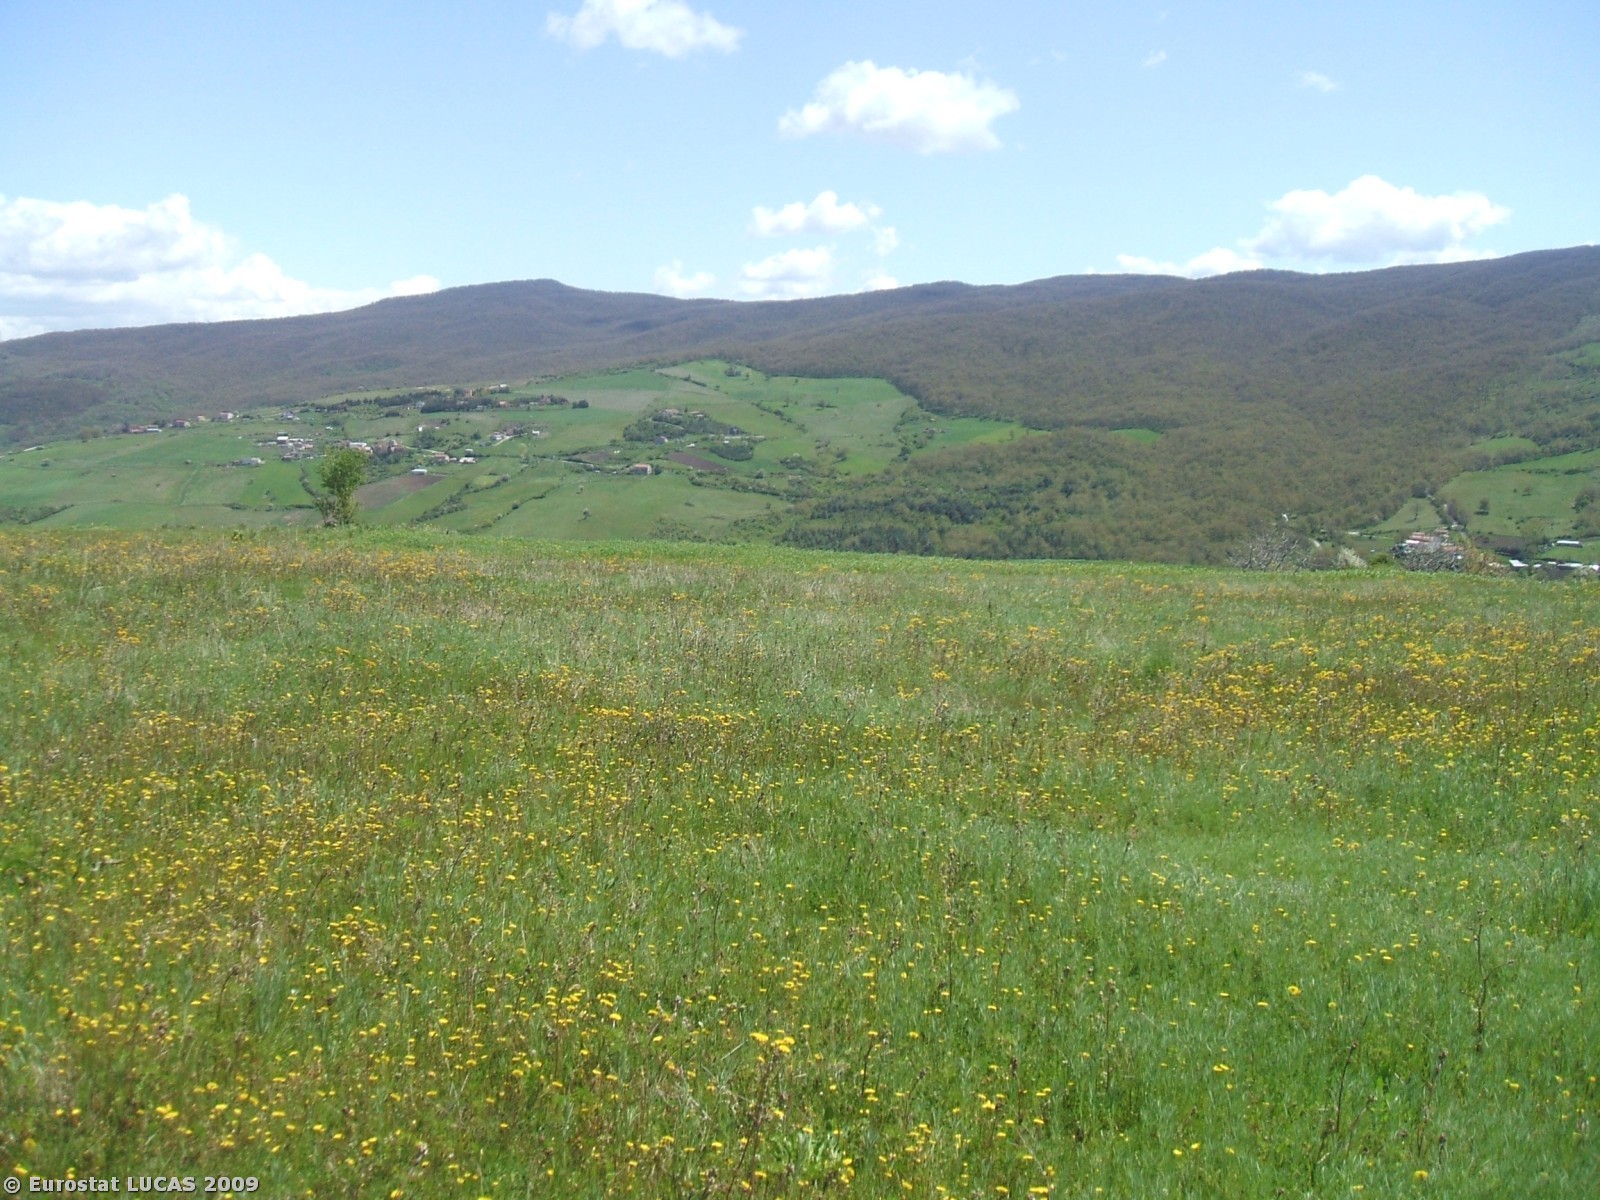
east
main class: Grassland
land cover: Grassland without tree/shrub cover
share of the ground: > 75 %
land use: Agriculture (excluding fallow land and kitchen gardens)
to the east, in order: Grassland without tree/shrub cover; Durum wheat; Oats; Durum wheat
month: April
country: IT
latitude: 40.6019
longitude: 15.8272
